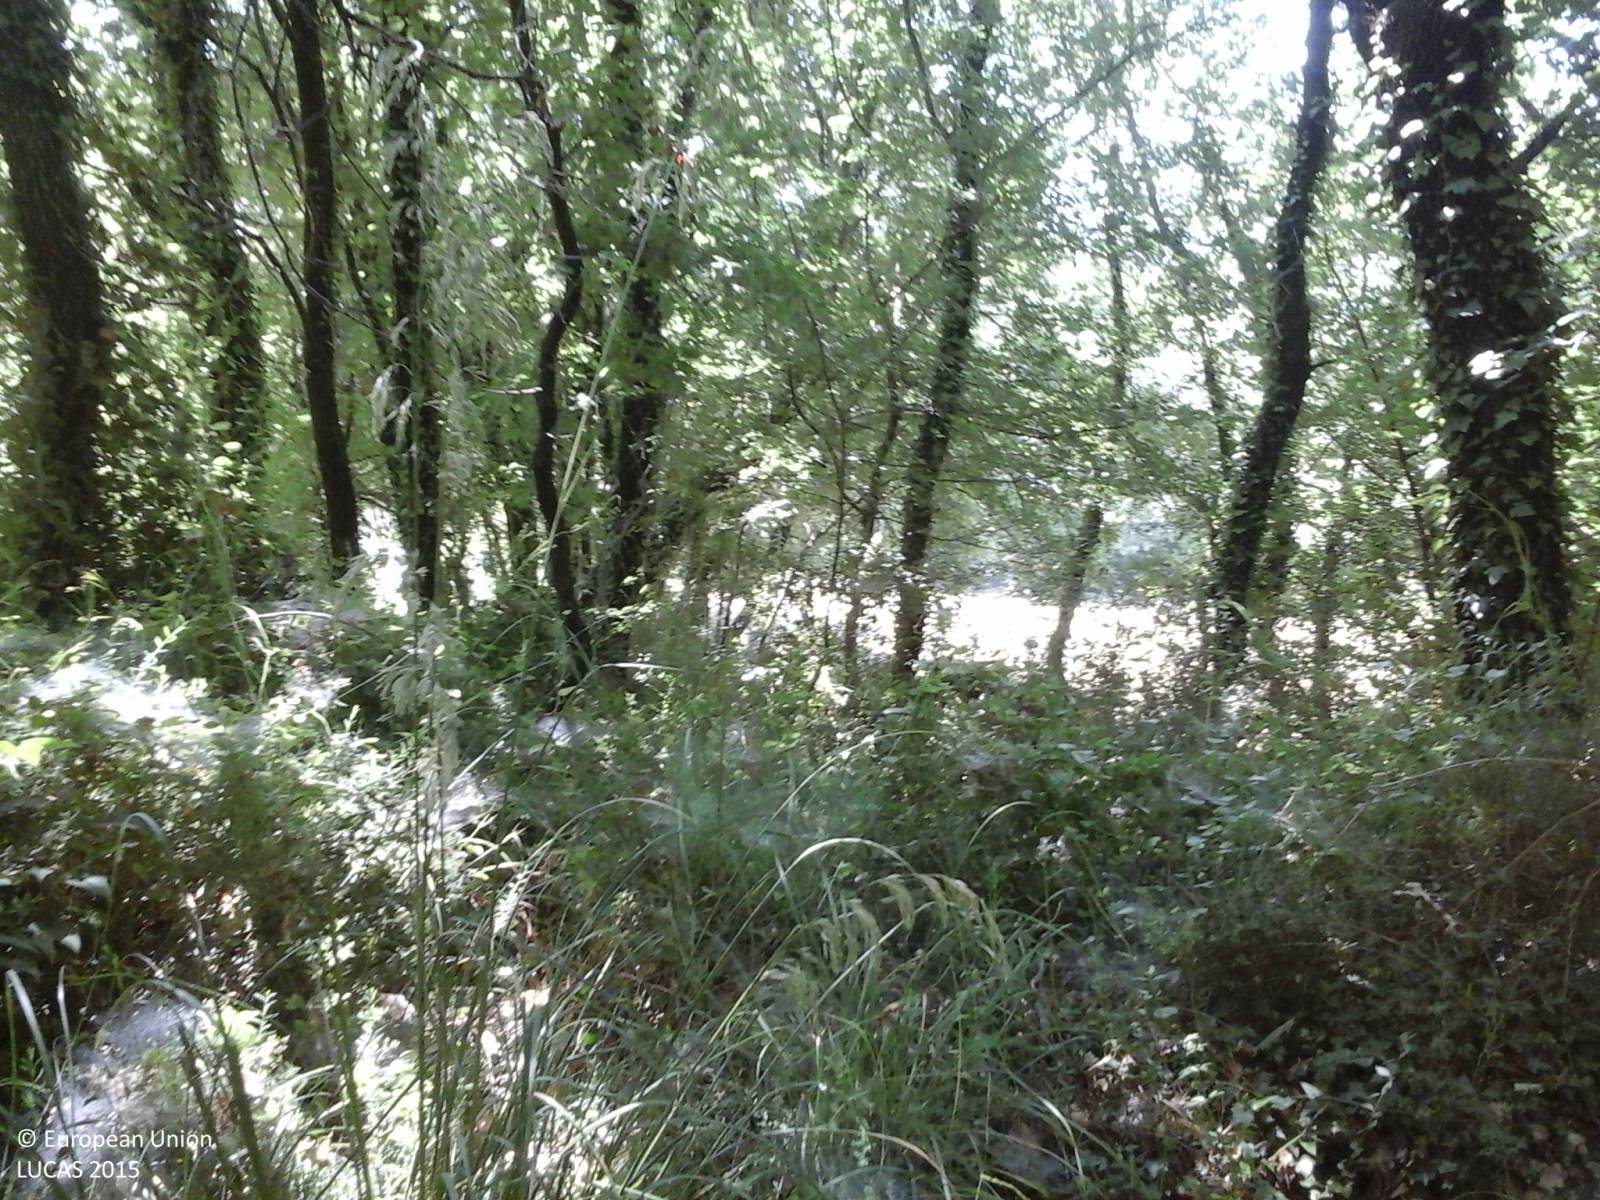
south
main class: Woodland
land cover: Broadleaved woodland
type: thermophilous deciduous forest
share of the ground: > 75 %
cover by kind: broadleaved forest trees 100 %
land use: Forestry
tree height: < 5 m
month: June
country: IT
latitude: 41.3205
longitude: 14.1535
